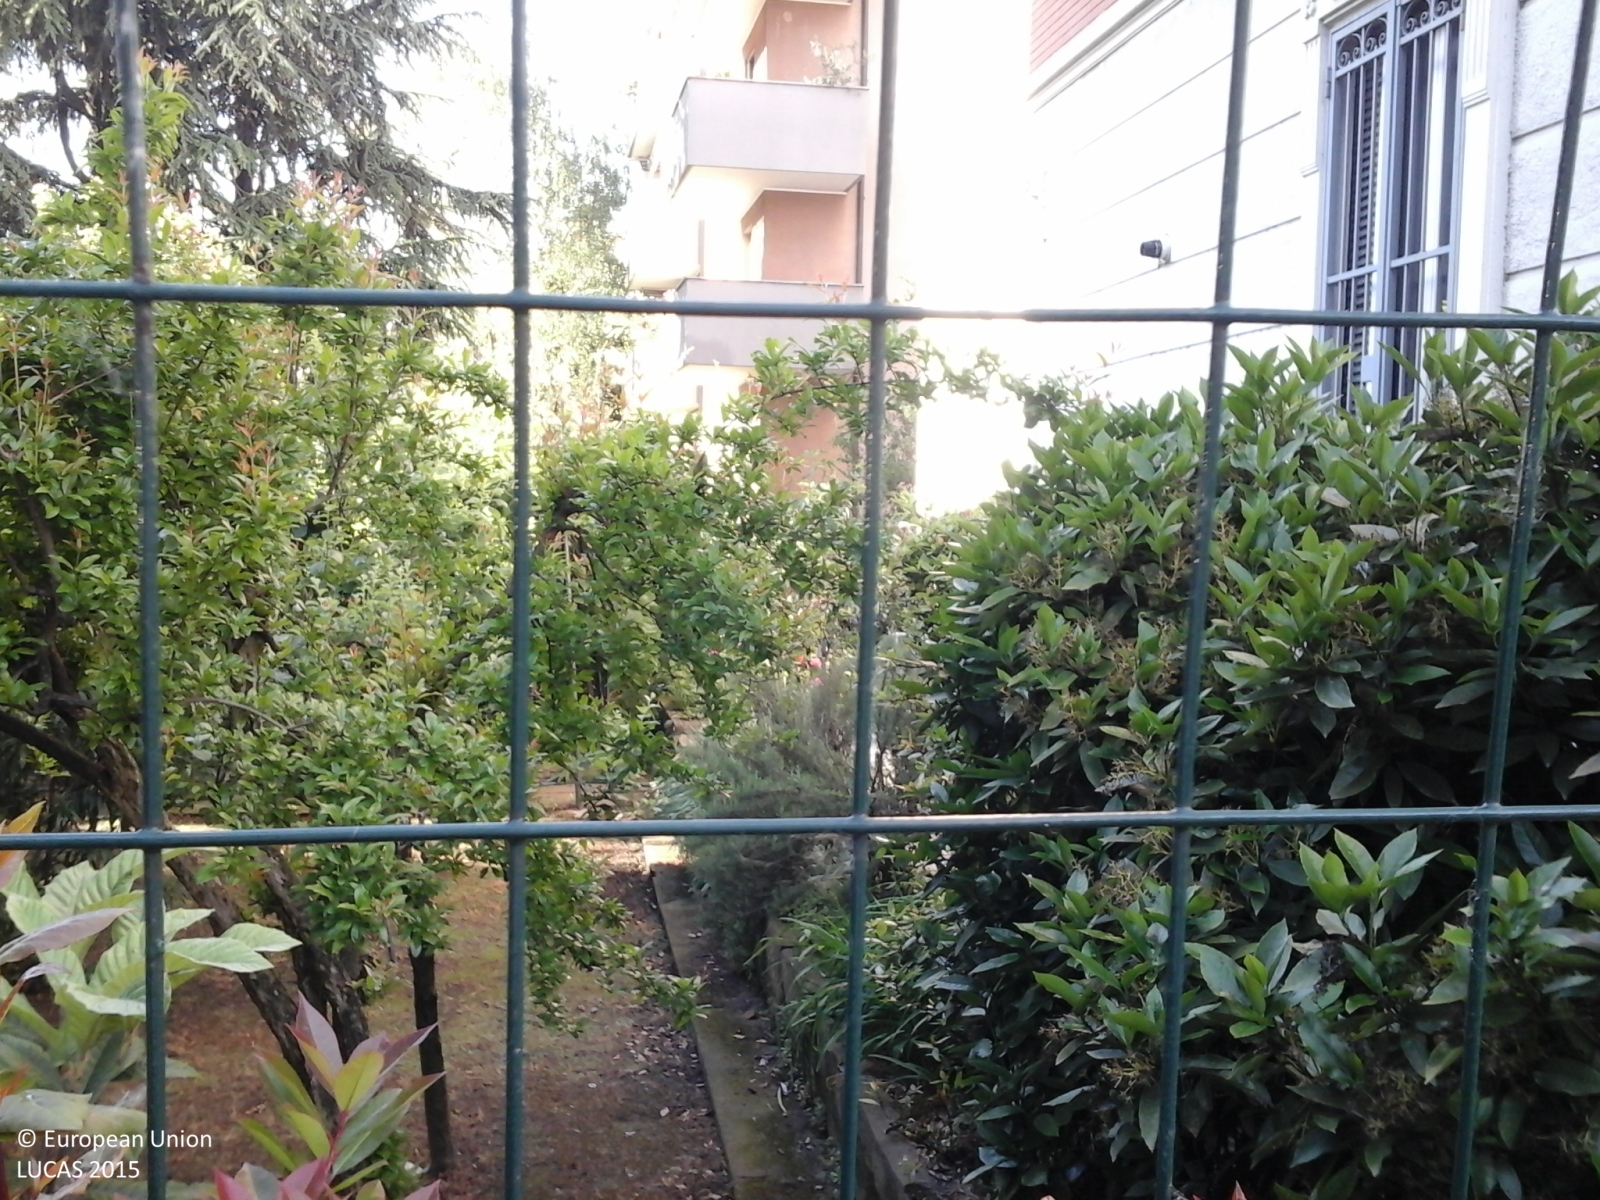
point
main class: Woodland
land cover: Broadleaved woodland
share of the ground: 50 - 75 %
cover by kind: broadleaved forest trees 50 %, shrubs 30 %, herbaceous plants 20 %
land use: Residential
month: May
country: IT
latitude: 45.4645
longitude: 9.0935
